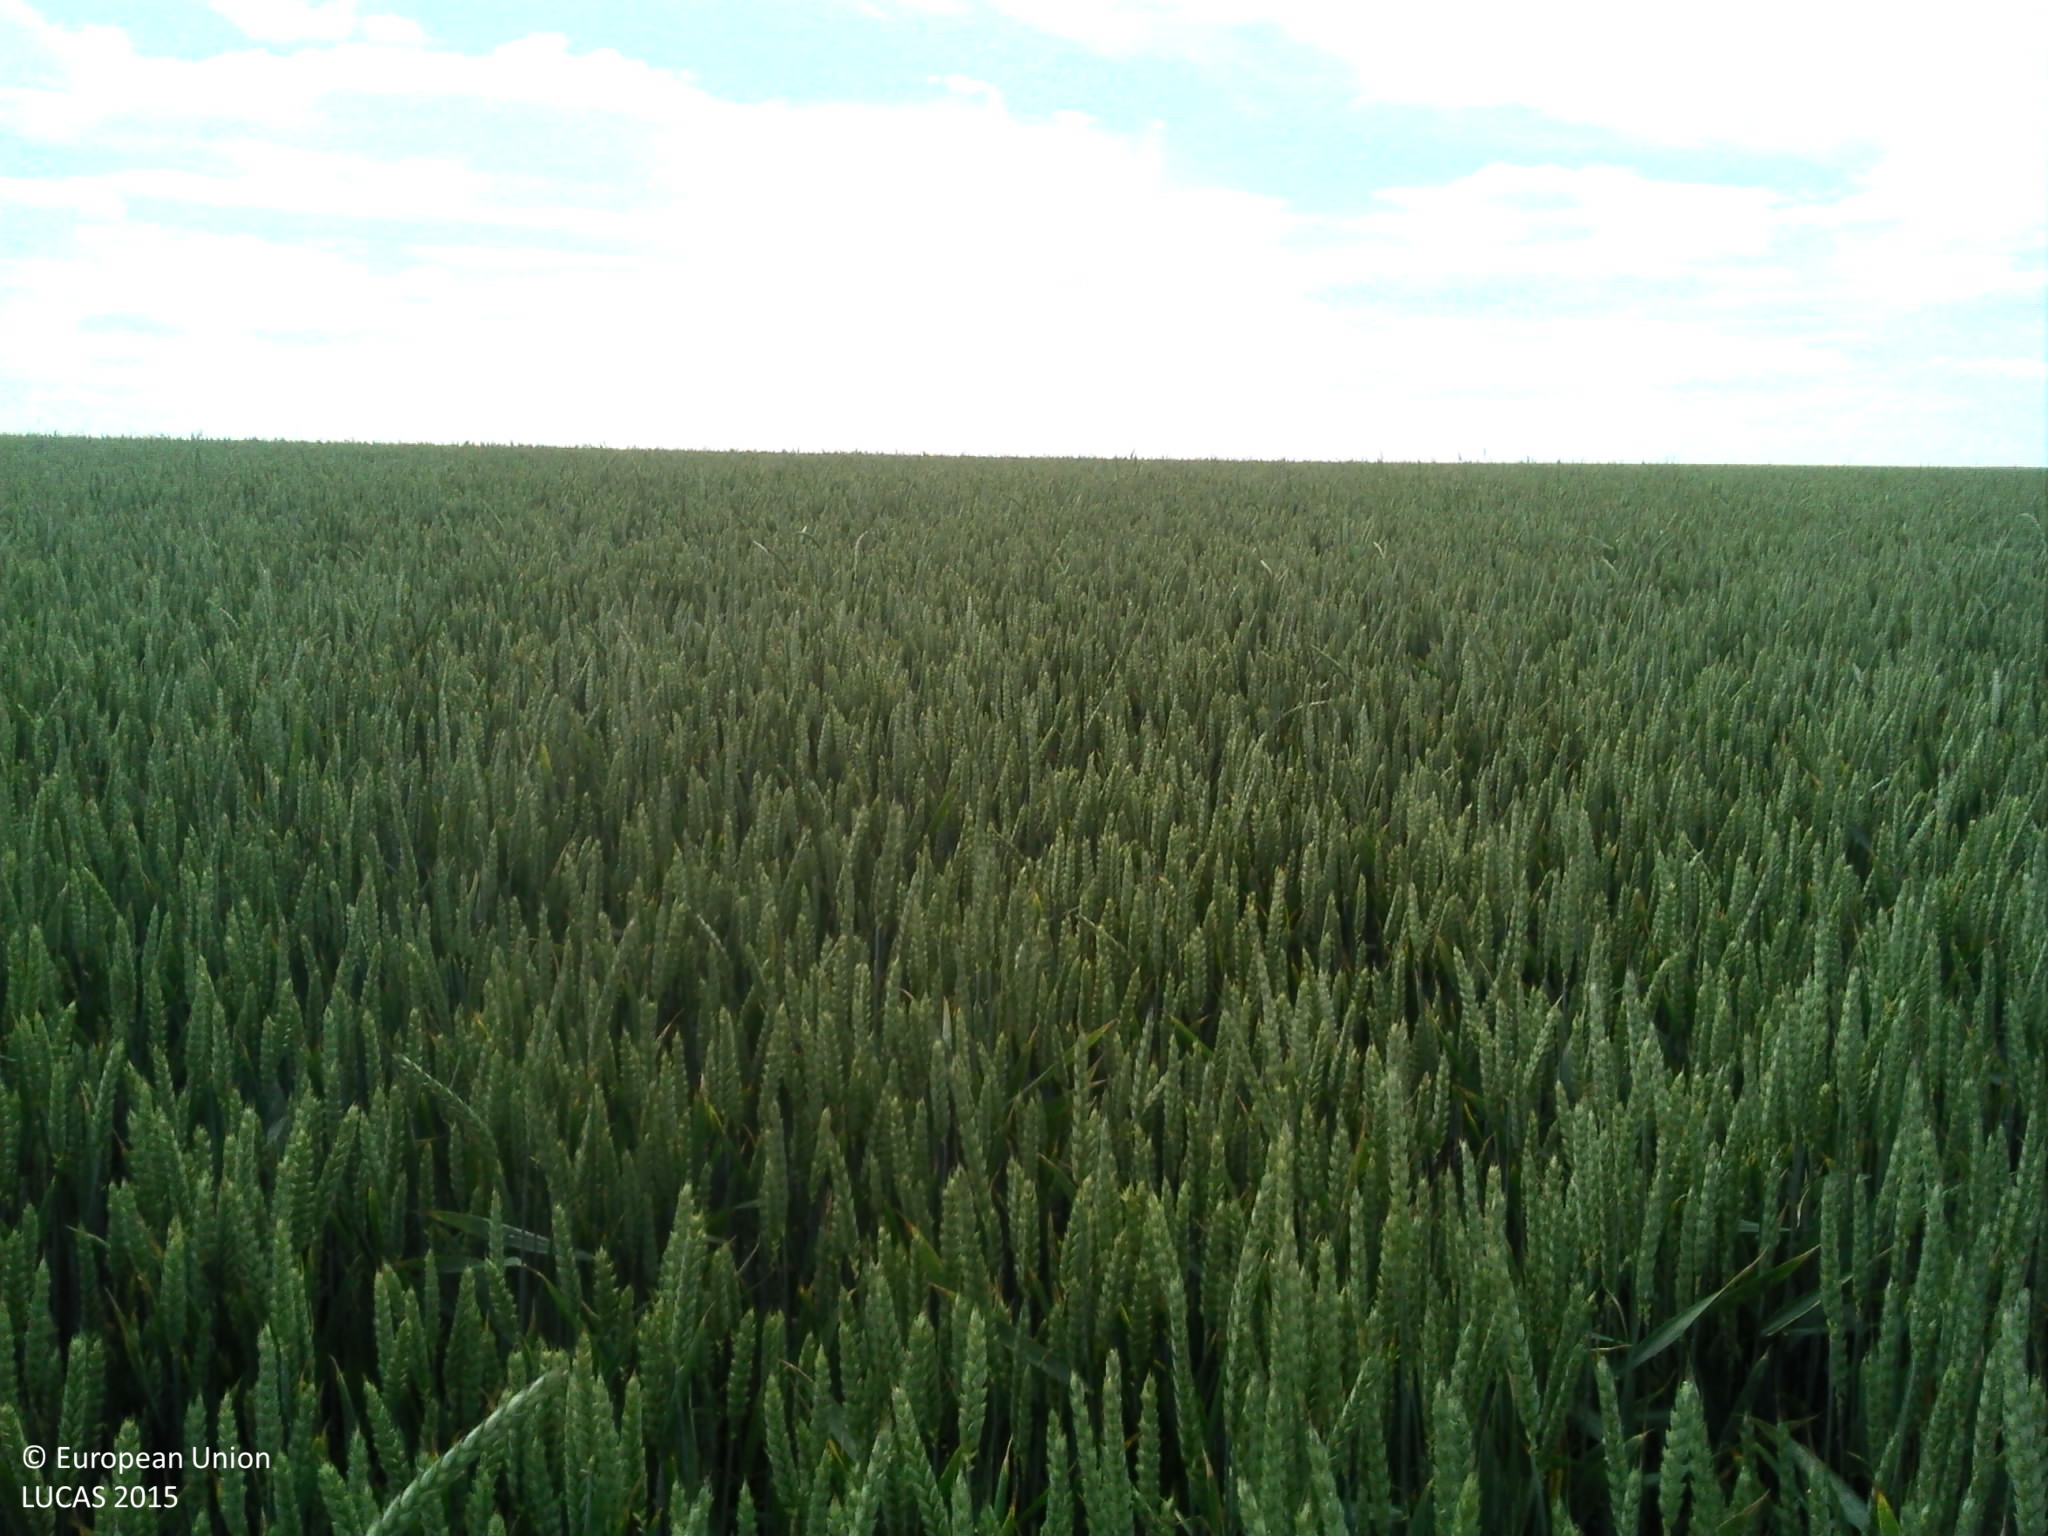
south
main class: Cropland
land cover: Common wheat
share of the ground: > 75 %
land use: Agriculture (excluding fallow land and kitchen gardens)
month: June
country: FR
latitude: 49.6780
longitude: 2.4067
